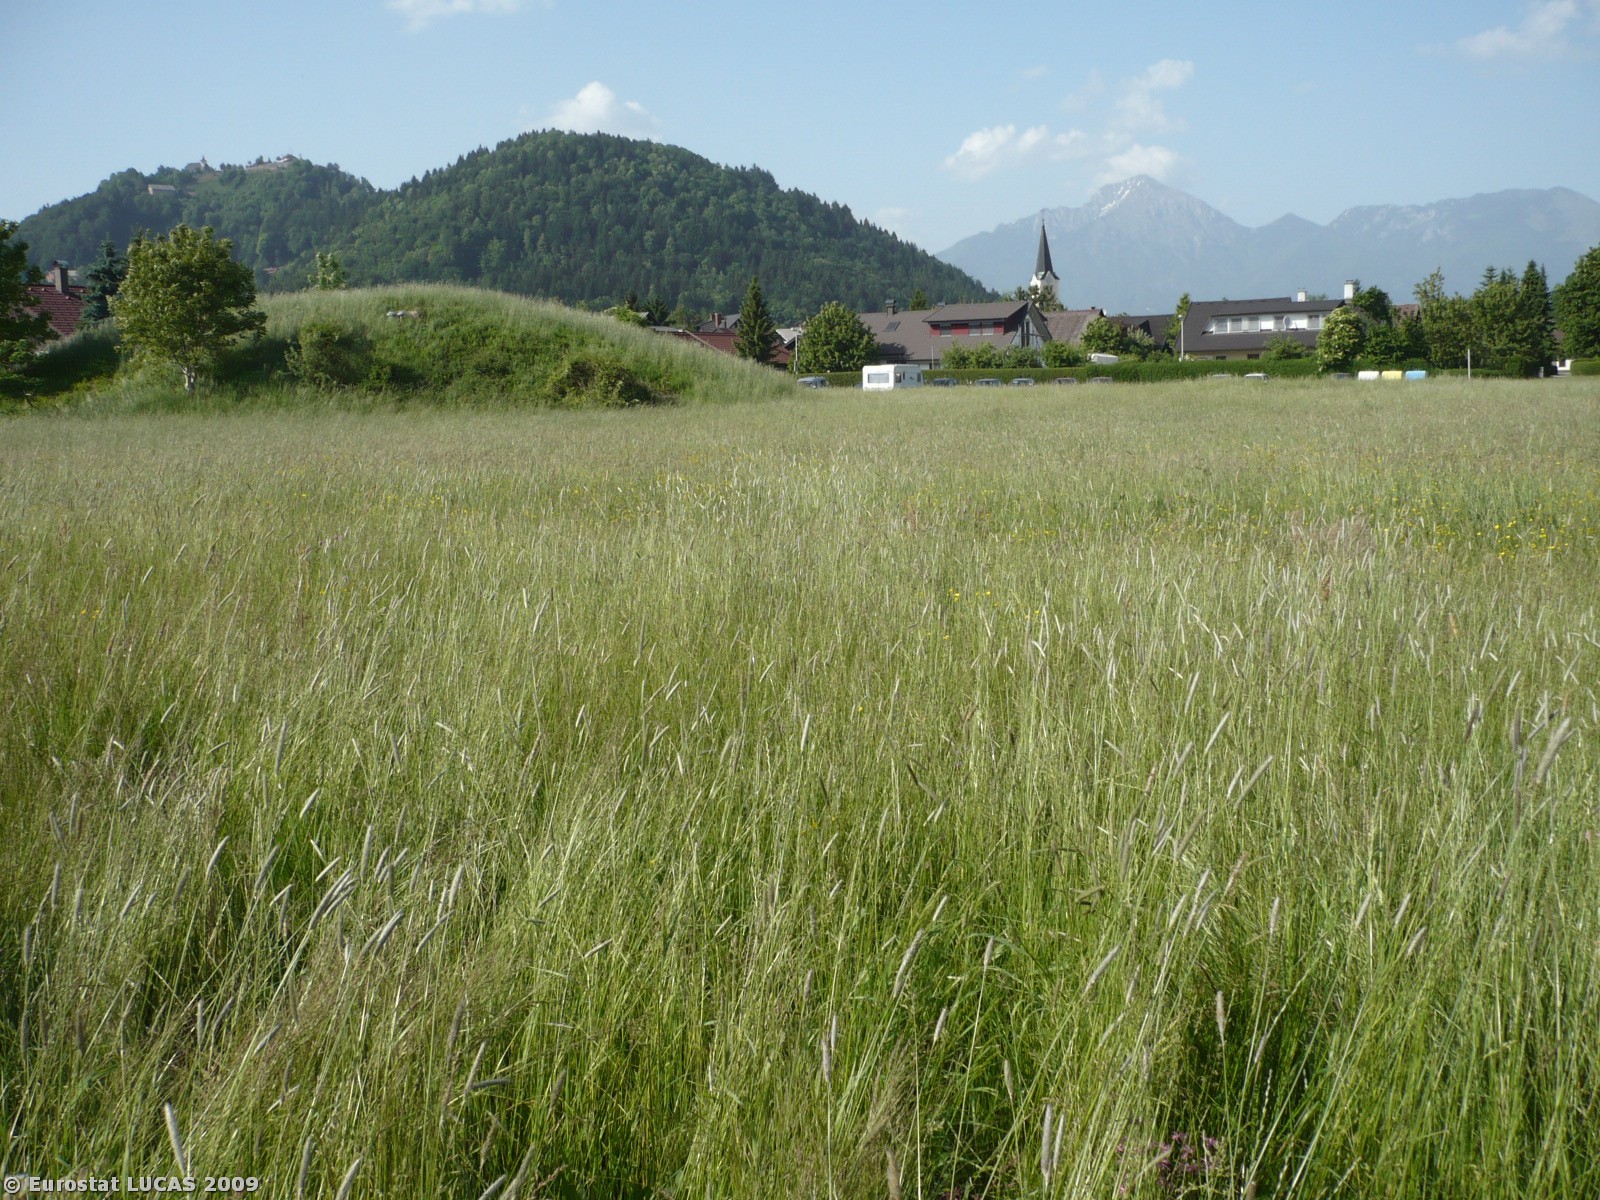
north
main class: Grassland
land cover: Grassland without tree/shrub cover
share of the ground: > 75 %
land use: Agriculture (excluding fallow land and kitchen gardens)
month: May
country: SI
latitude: 46.2271
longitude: 14.3402
